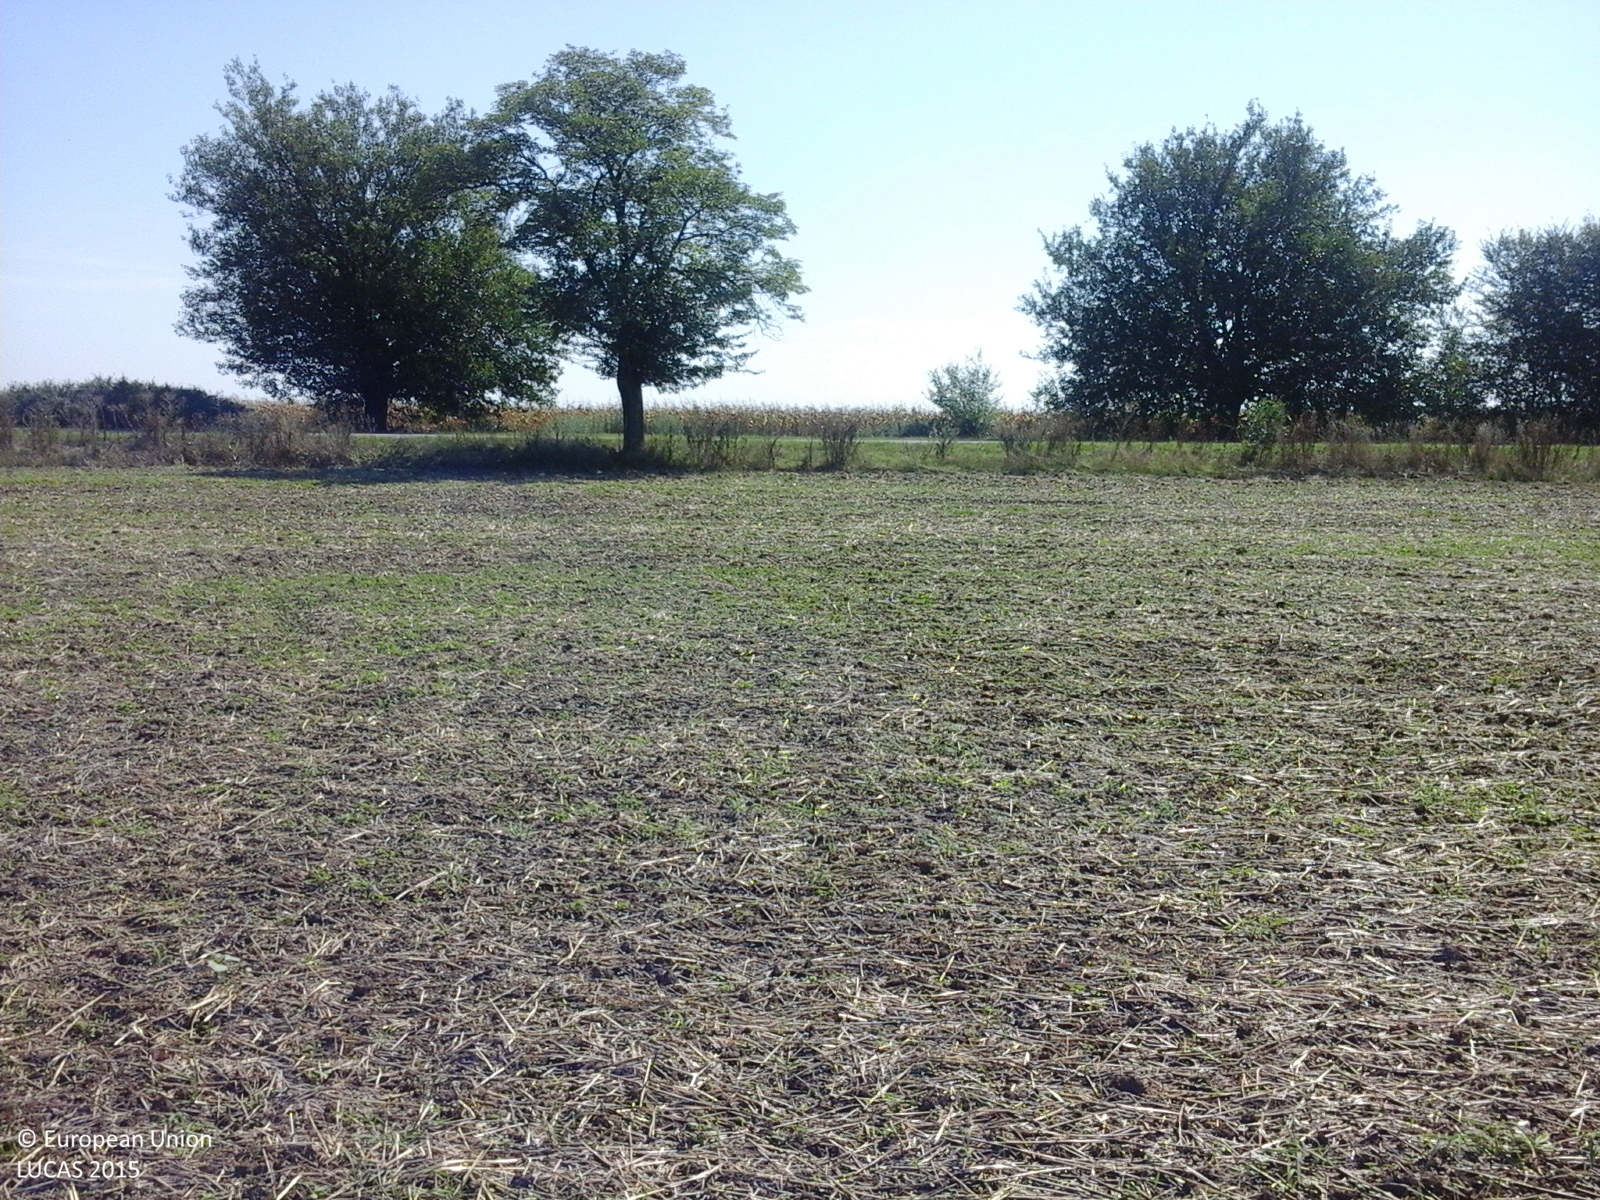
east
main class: Cropland
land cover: Common wheat
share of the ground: 10 - 25 %
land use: Agriculture (excluding fallow land and kitchen gardens)
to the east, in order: Common wheat; Lines of trees; Paved roads, cycling and walking lanes; Lines of trees; Maize
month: August
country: RO
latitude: 45.8879
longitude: 21.2035
